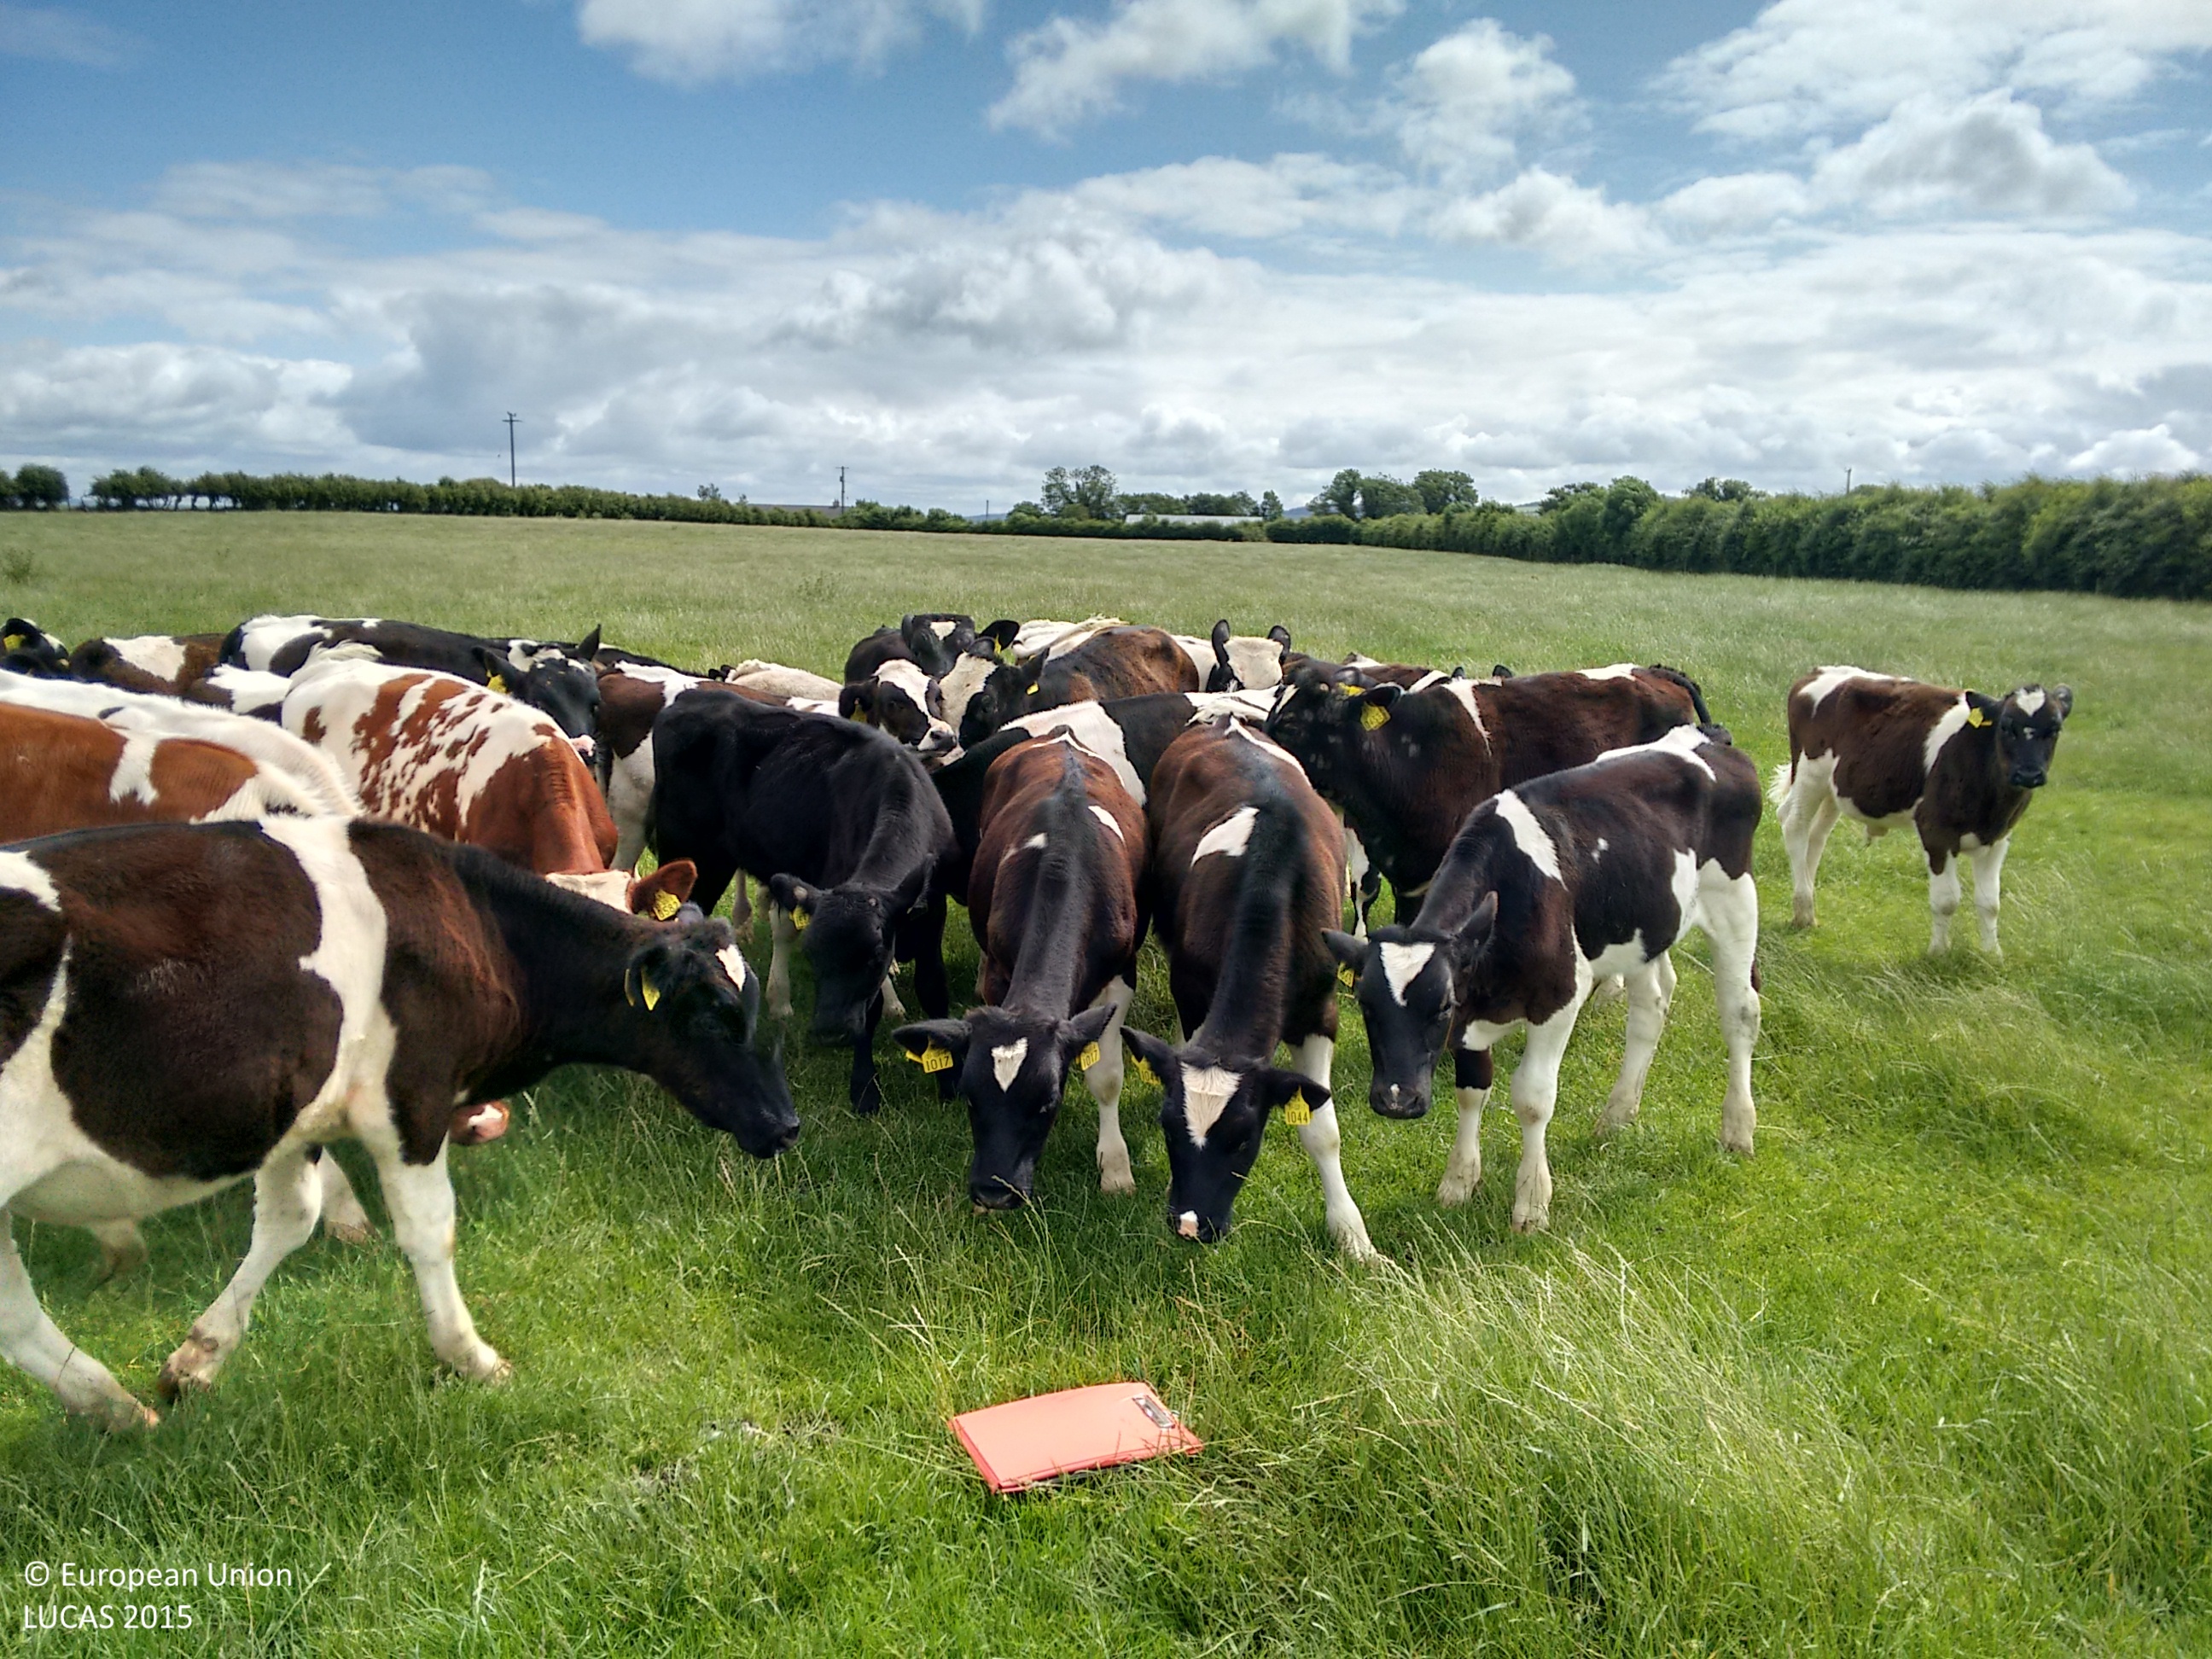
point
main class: Grassland
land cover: Grassland without tree/shrub cover
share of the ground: > 75 %
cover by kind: herbaceous plants 100 %
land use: Agriculture (excluding fallow land and kitchen gardens)
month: July
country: IE
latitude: 52.8038
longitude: -7.5604
